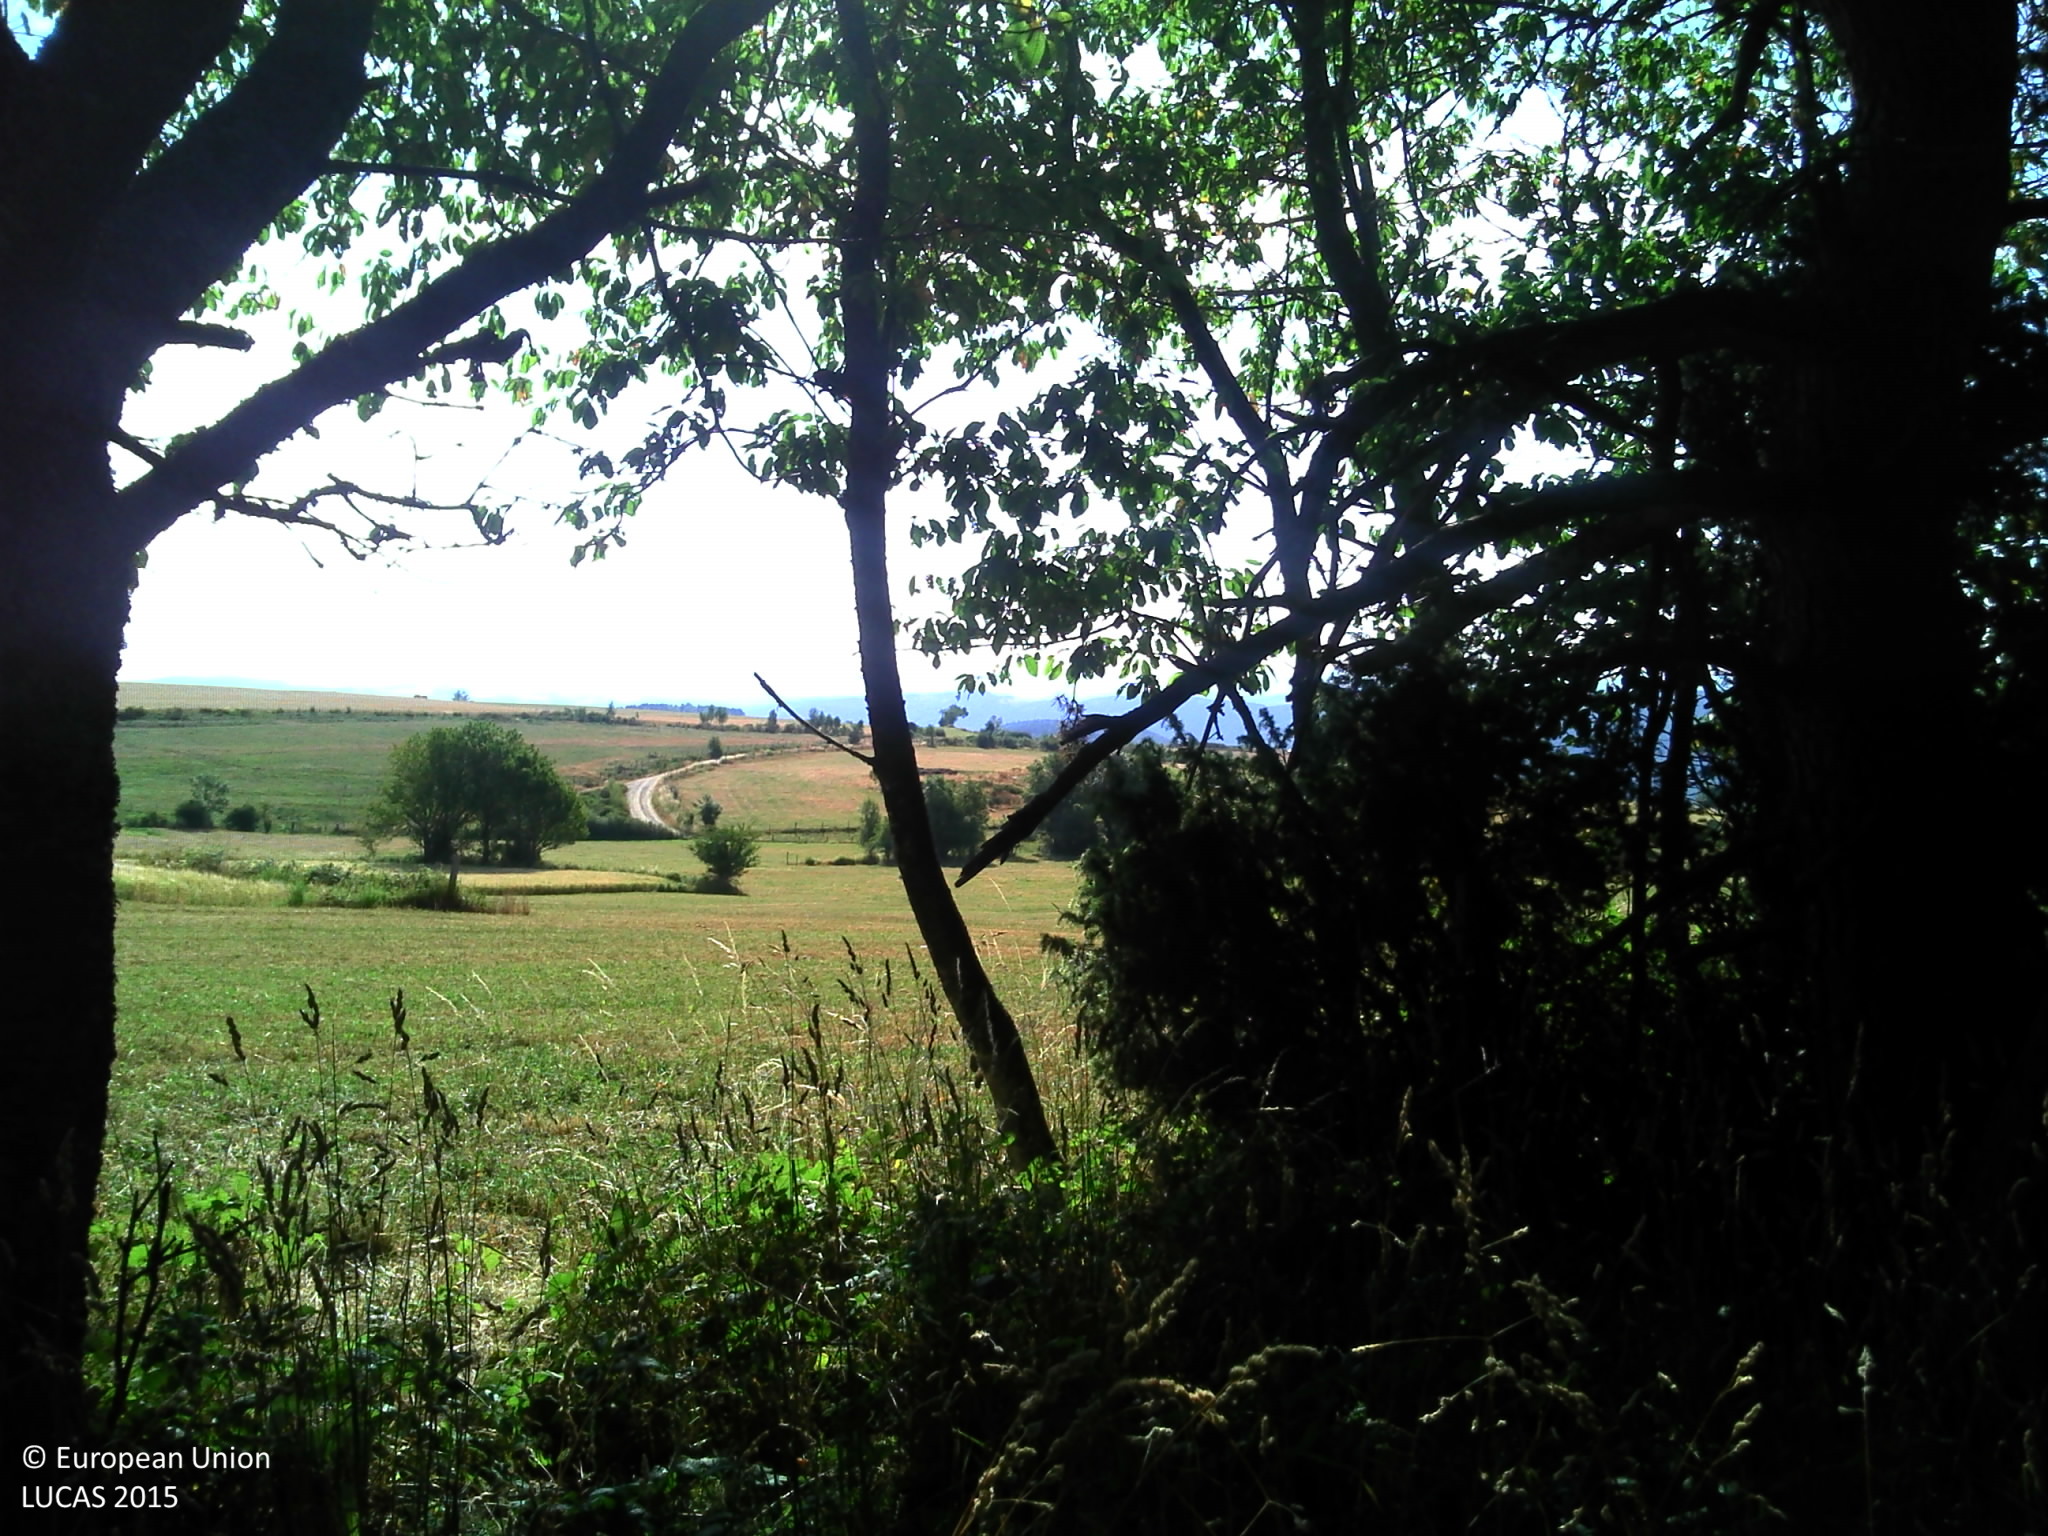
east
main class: Woodland
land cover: Pine dominated mixed woodland
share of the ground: > 75 %
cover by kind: coniferous forest trees 75 %, broadleaved forest trees 25 %
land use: Semi-natural and natural areas not in use
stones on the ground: < 10 %
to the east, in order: Pine dominated mixed woodland; Grassland without tree/shrub cover; Fences; Grassland without tree/shrub cover; Abandoned hedges; Ditches and canals; Grass margins; Tracks; Fences; Grassland without tree/shrub cover
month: July
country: FR
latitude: 45.0276
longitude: 3.4160
